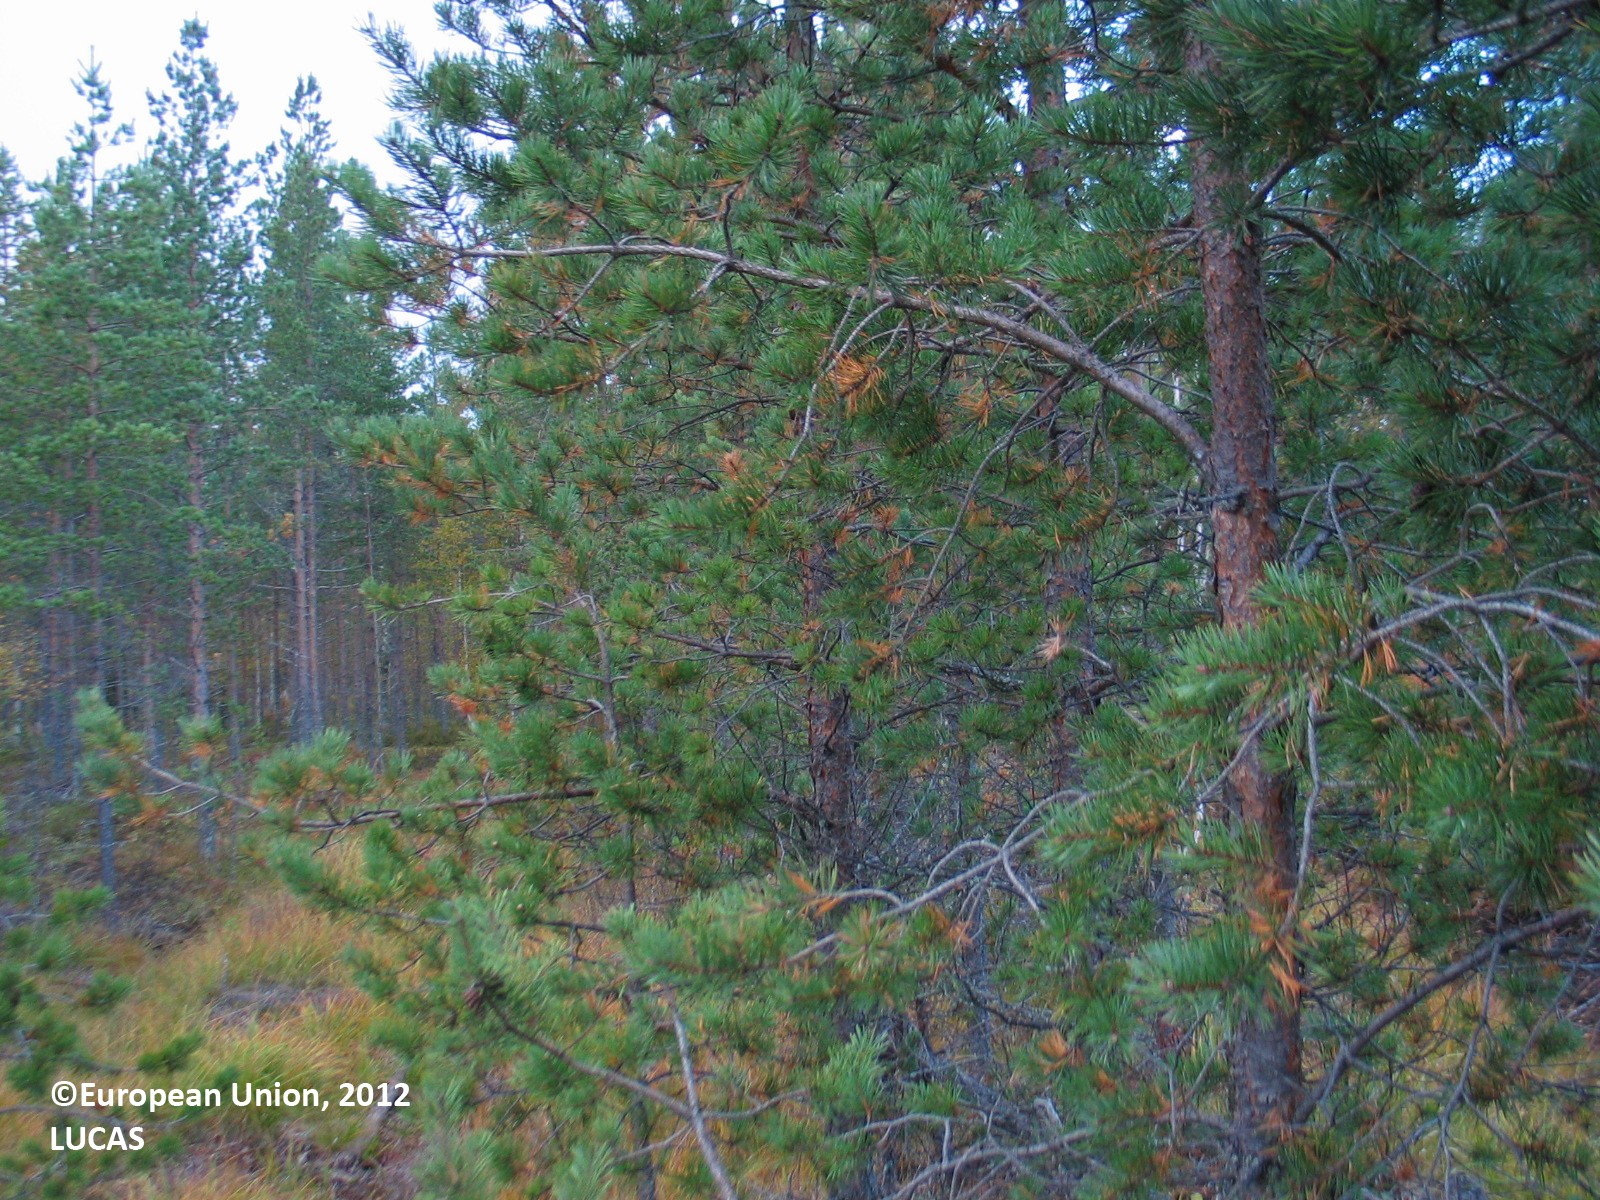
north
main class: Woodland
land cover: Pine dominated coniferous woodland
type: mire and swamp forests
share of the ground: 25 - 50 %
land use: Forestry
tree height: > 5 m
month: September
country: FI
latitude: 65.5402
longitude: 25.6425
